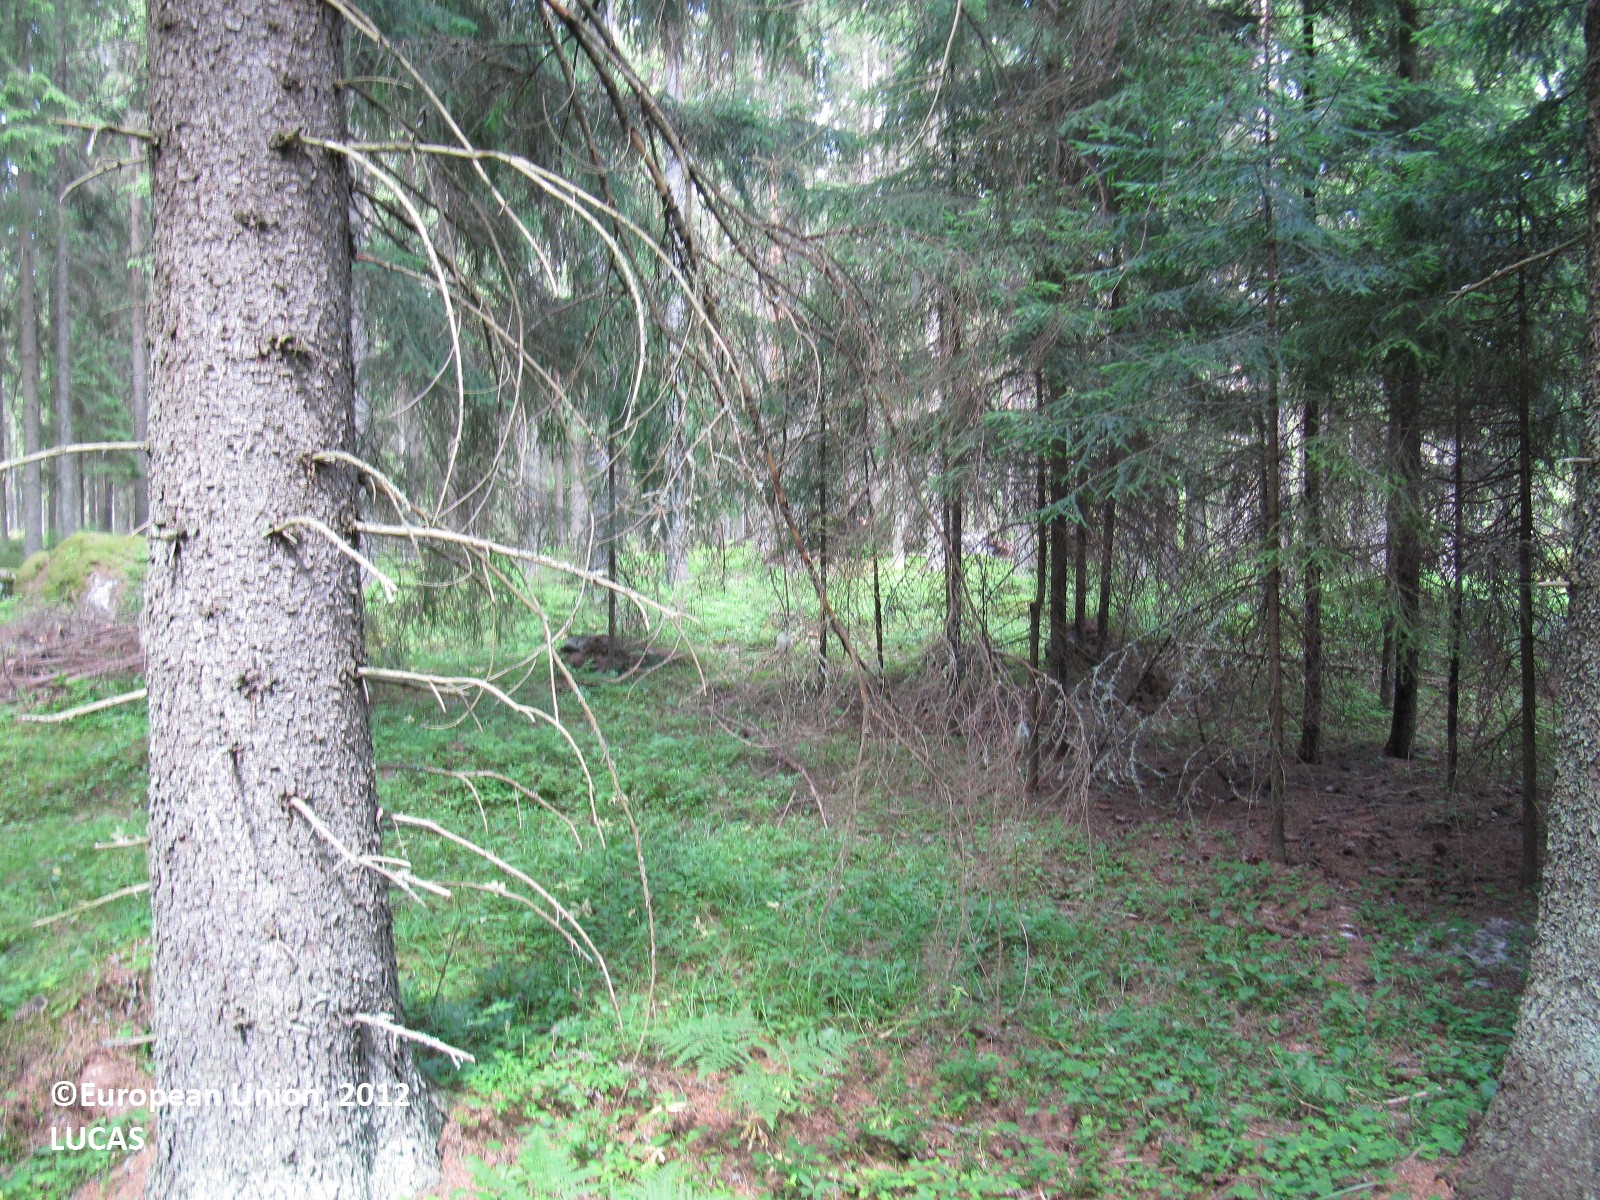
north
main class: Woodland
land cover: Spruce dominated coniferous woodland
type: boreal forest
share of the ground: > 75 %
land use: Forestry
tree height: > 5 m
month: July
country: FI
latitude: 61.0149
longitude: 23.4574
